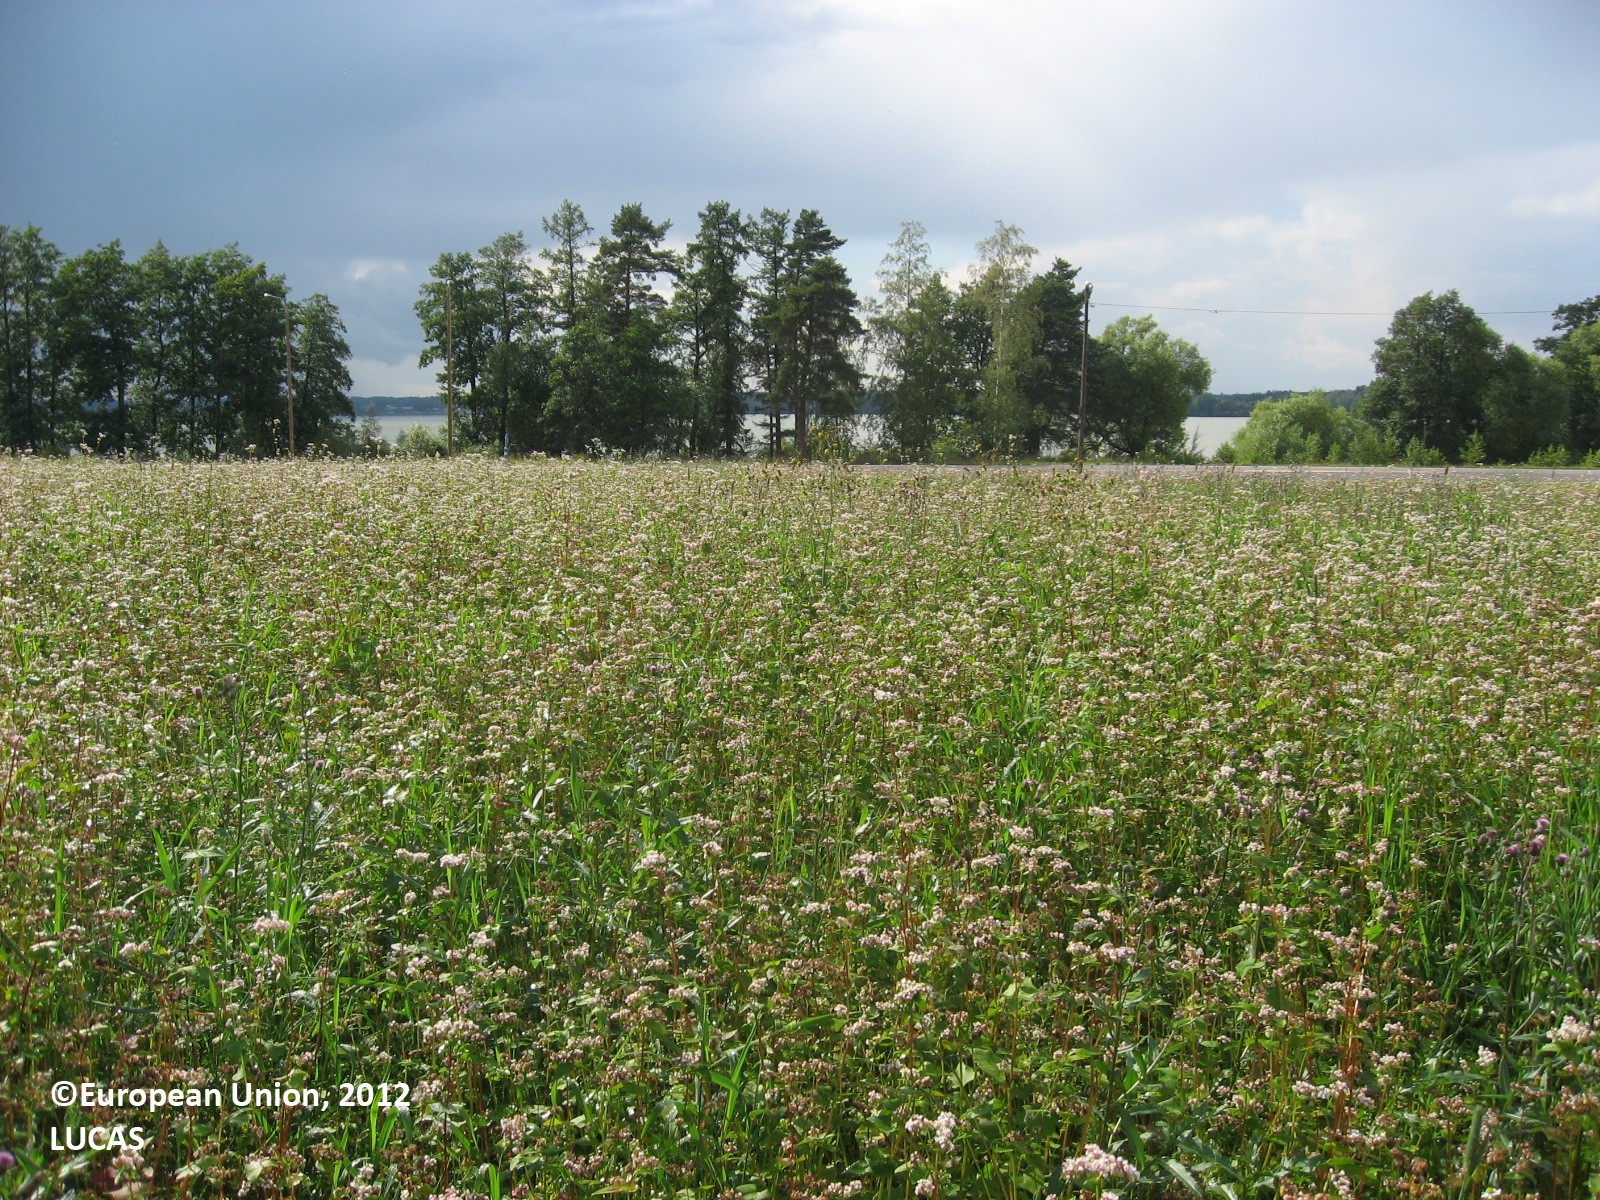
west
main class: Cropland
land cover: Other cereals
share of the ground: > 75 %
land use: Agriculture (excluding fallow land and kitchen gardens)
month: August
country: FI
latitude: 60.4477
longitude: 25.0787
